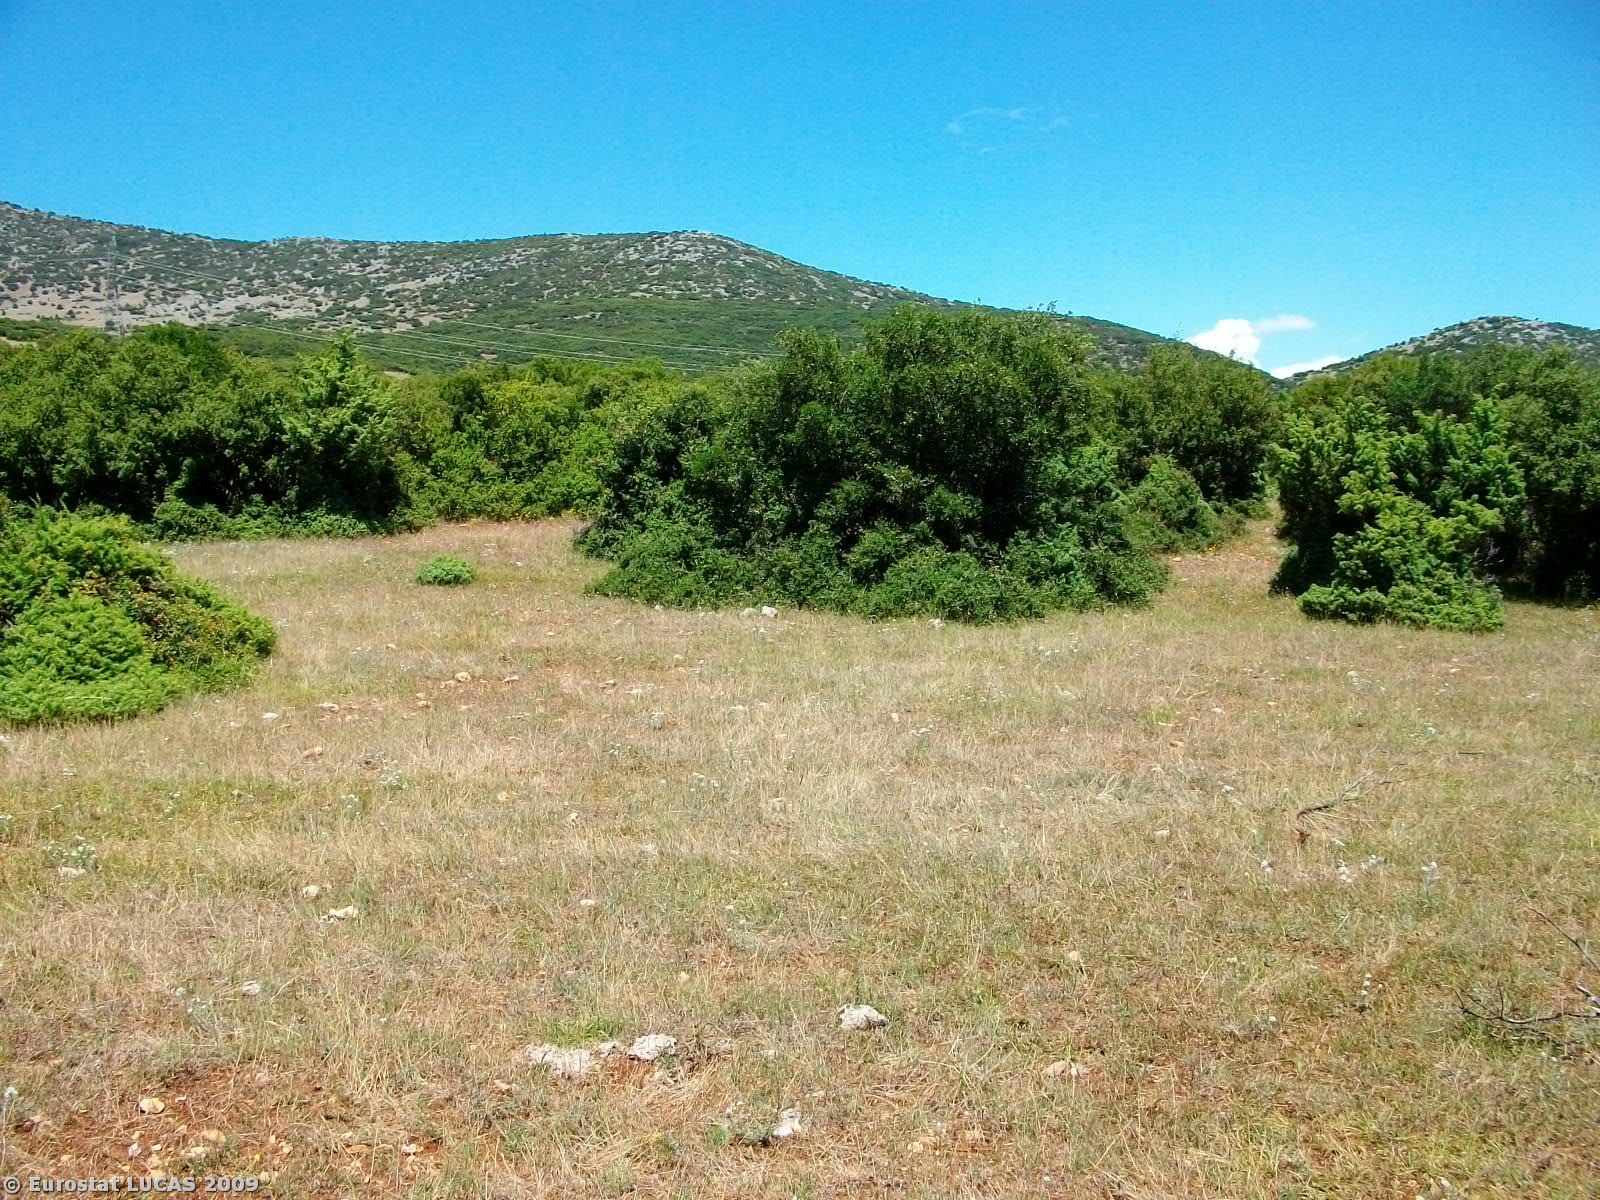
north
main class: Shrubland
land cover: Shrubland without tree cover
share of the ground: 50 - 75 %
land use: Unused
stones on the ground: 10 - 25 %
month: July
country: GR
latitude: 40.1209
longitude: 21.7825
